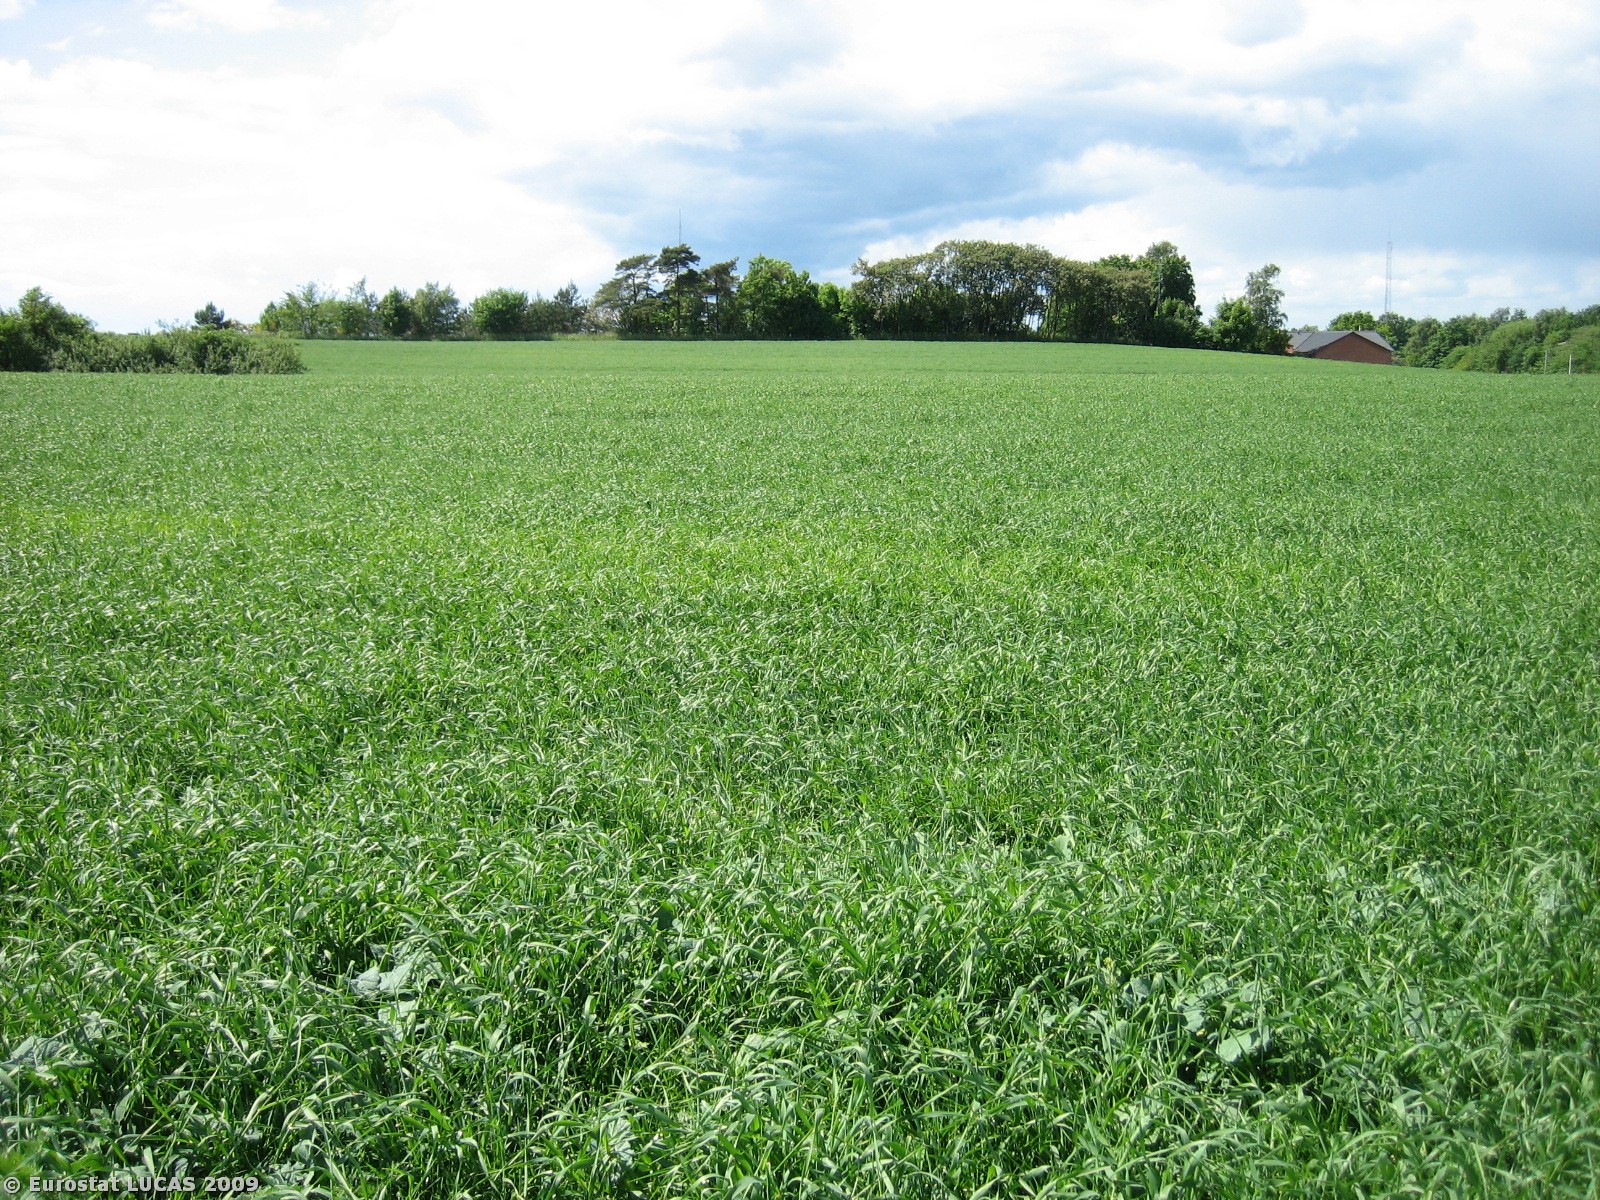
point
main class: Cropland
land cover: Barley
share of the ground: > 75 %
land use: Agriculture (excluding fallow land and kitchen gardens)
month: June
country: DK
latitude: 56.2954
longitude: 9.7902
